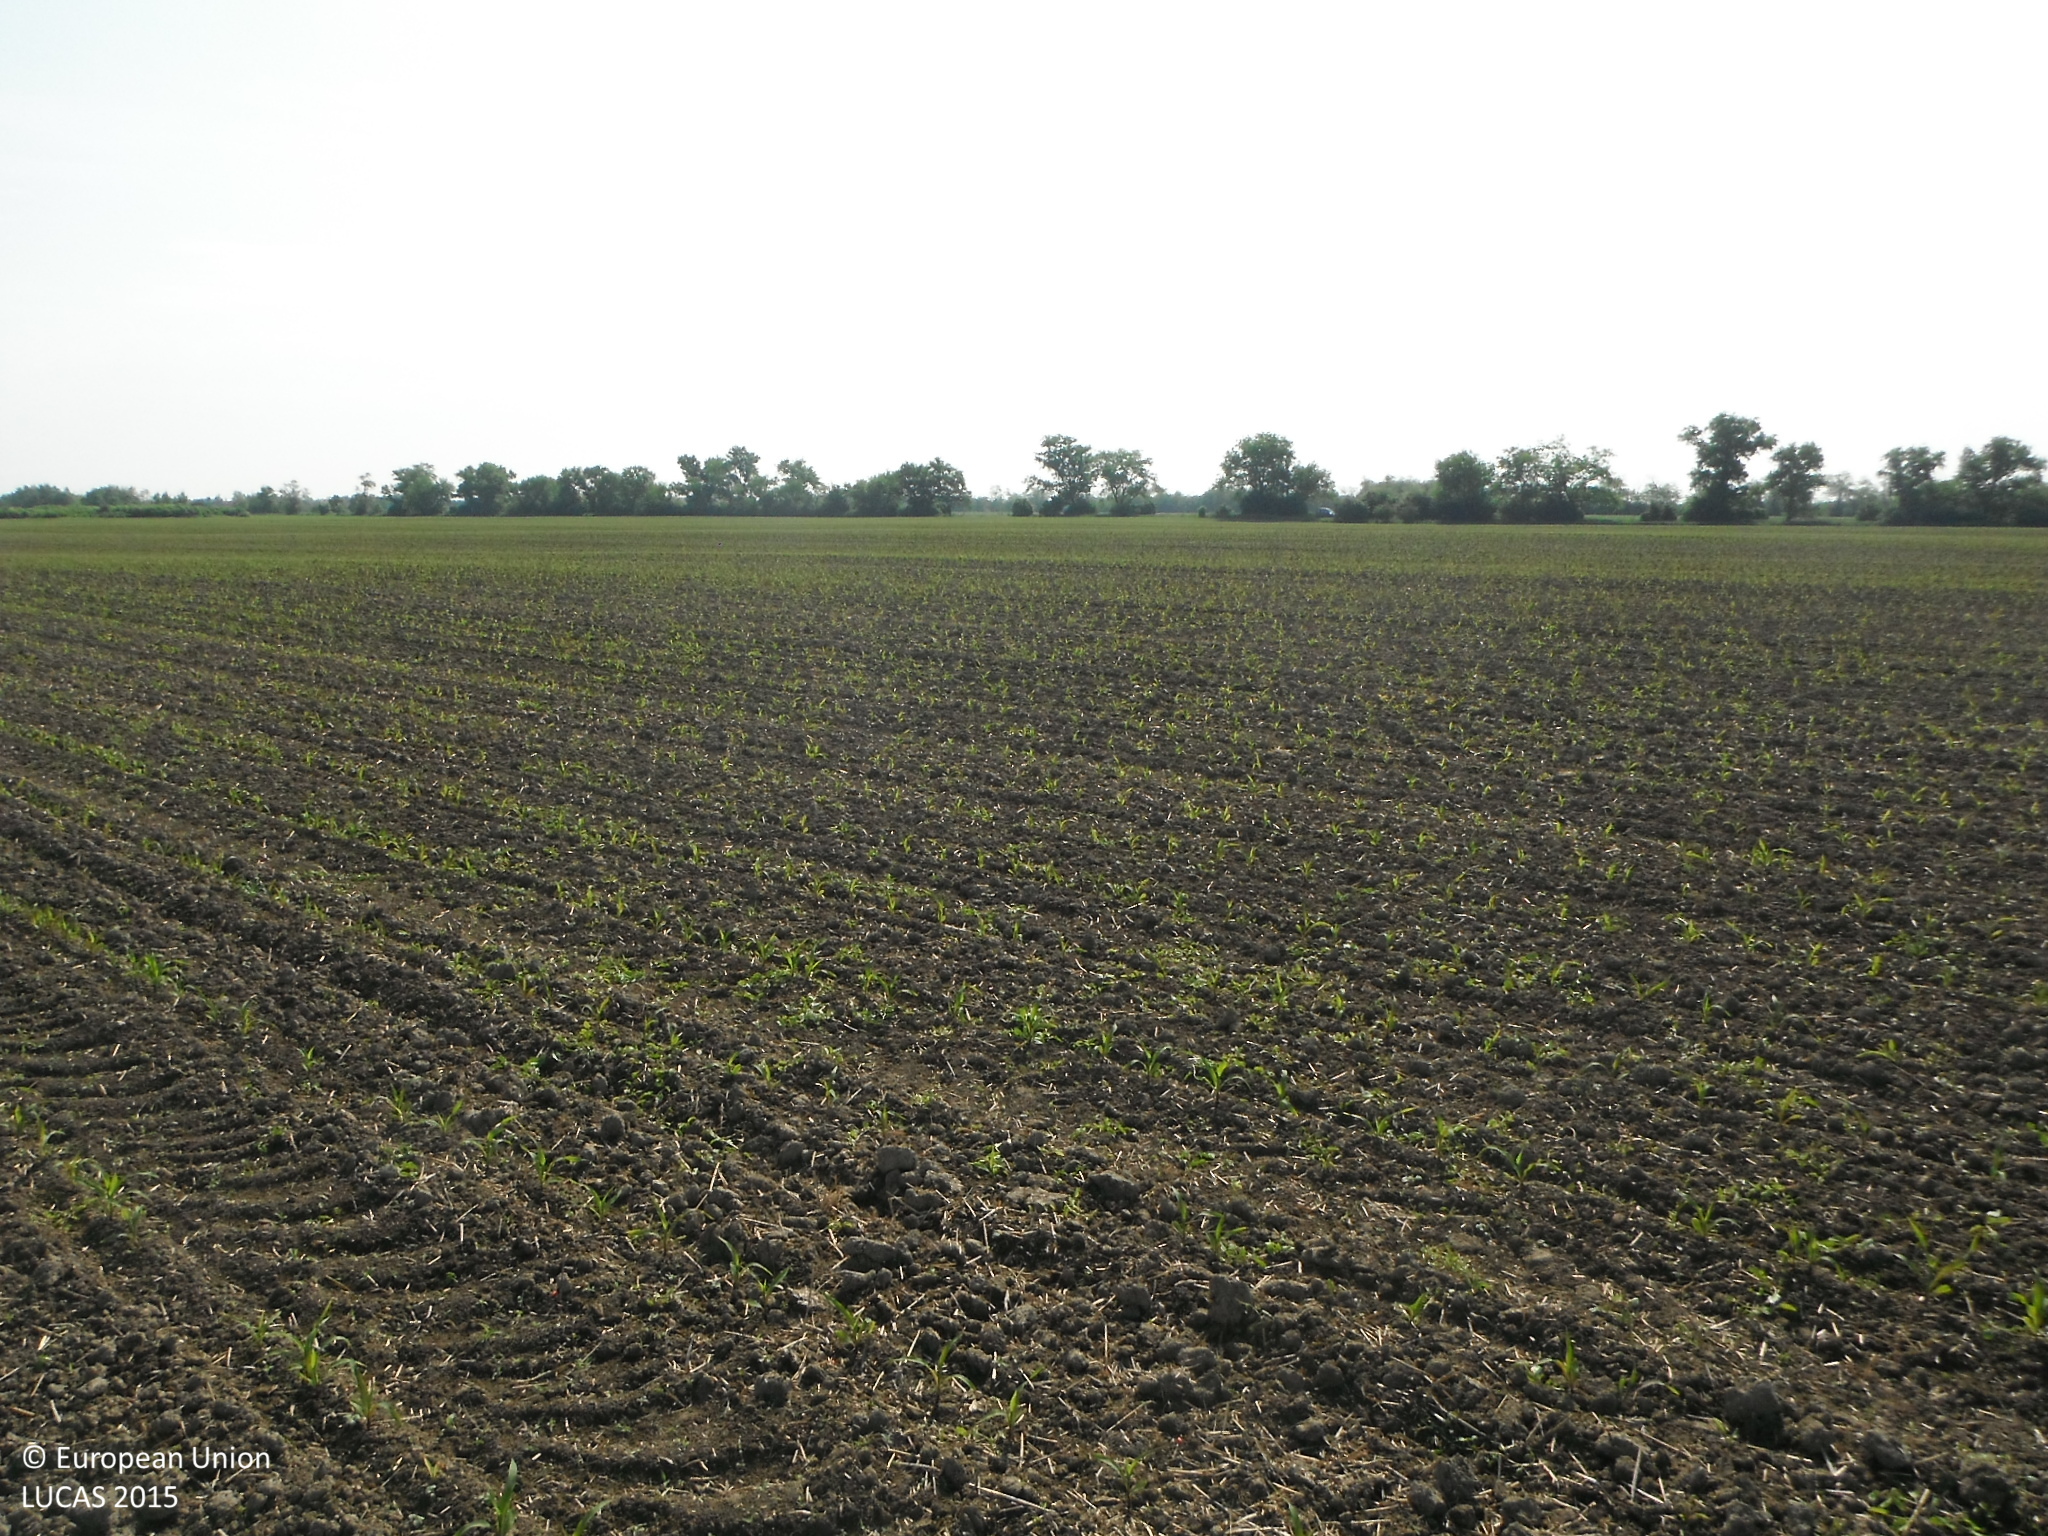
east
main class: Cropland
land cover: Maize
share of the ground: < 10 %
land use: Agriculture (excluding fallow land and kitchen gardens)
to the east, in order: Maize
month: May
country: SK
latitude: 48.0951
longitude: 17.2187
